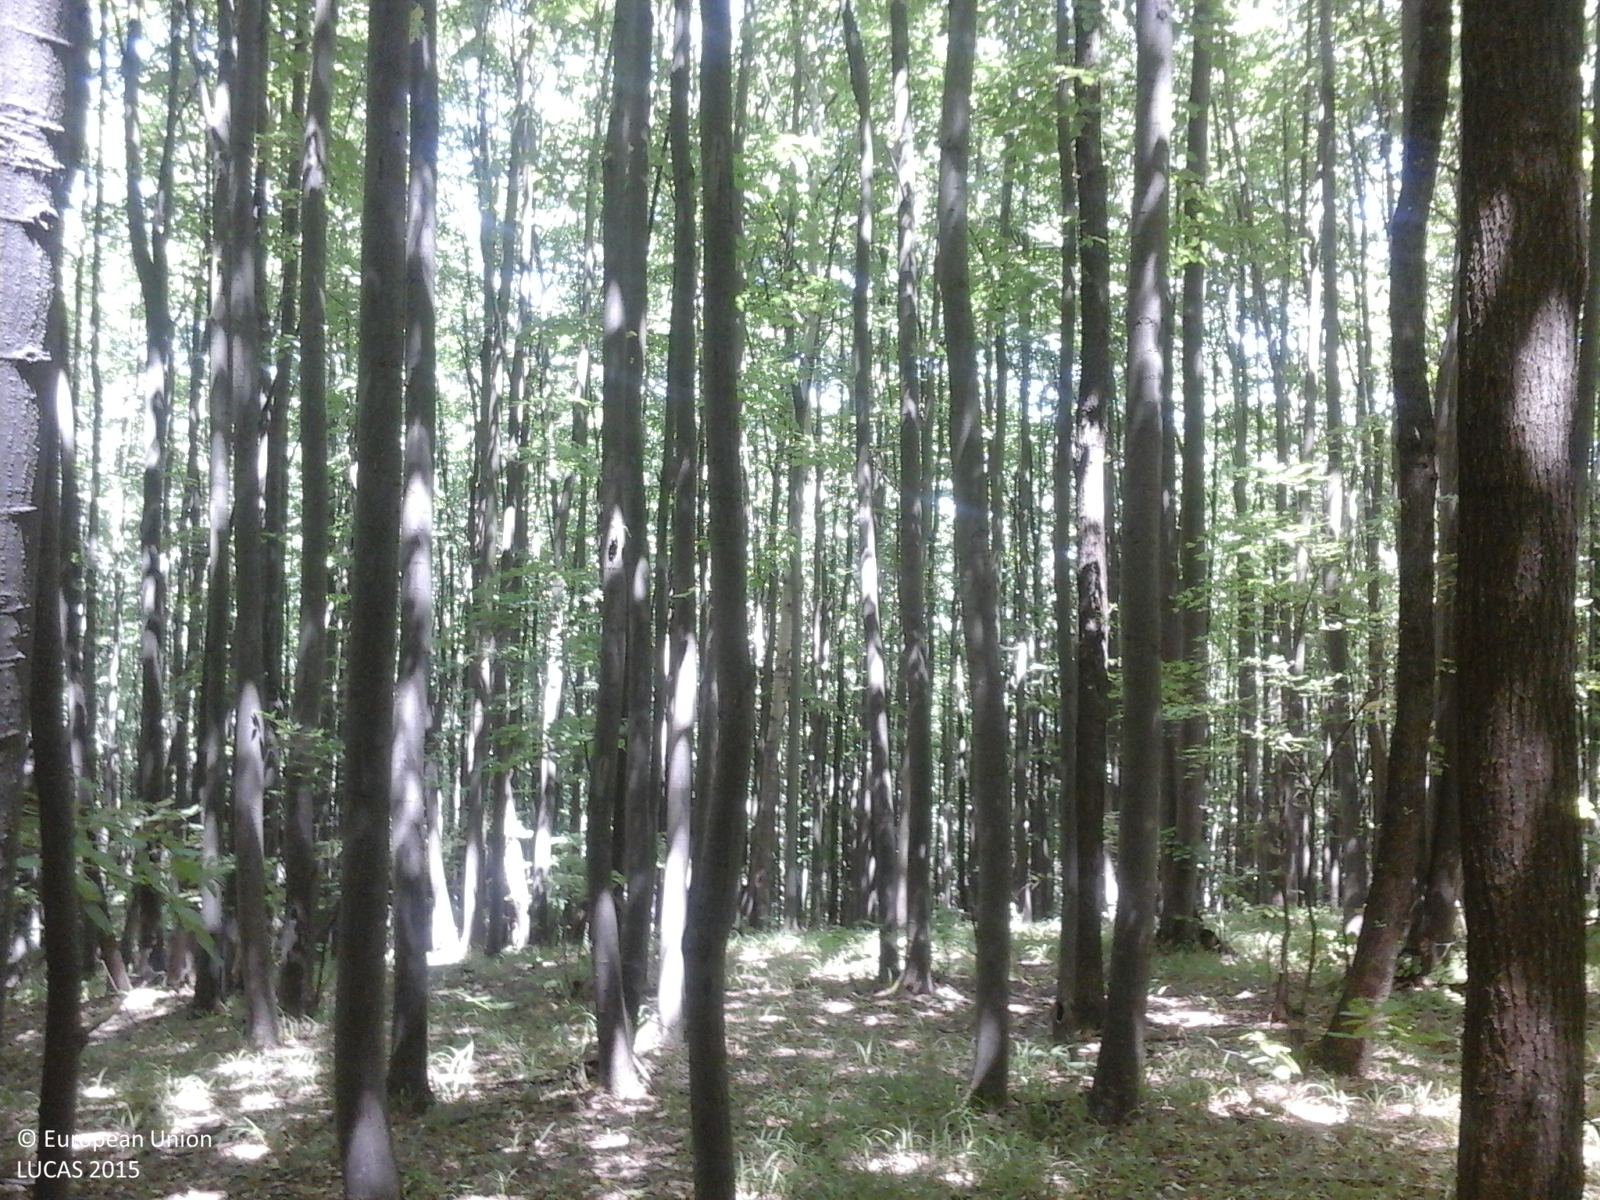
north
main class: Woodland
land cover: Broadleaved woodland
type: beech forest
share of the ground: > 75 %
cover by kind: broadleaved forest trees 95 %, herbaceous plants 5 %
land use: Forestry
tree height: > 5 m
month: June
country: RO
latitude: 45.0447
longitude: 26.1209
